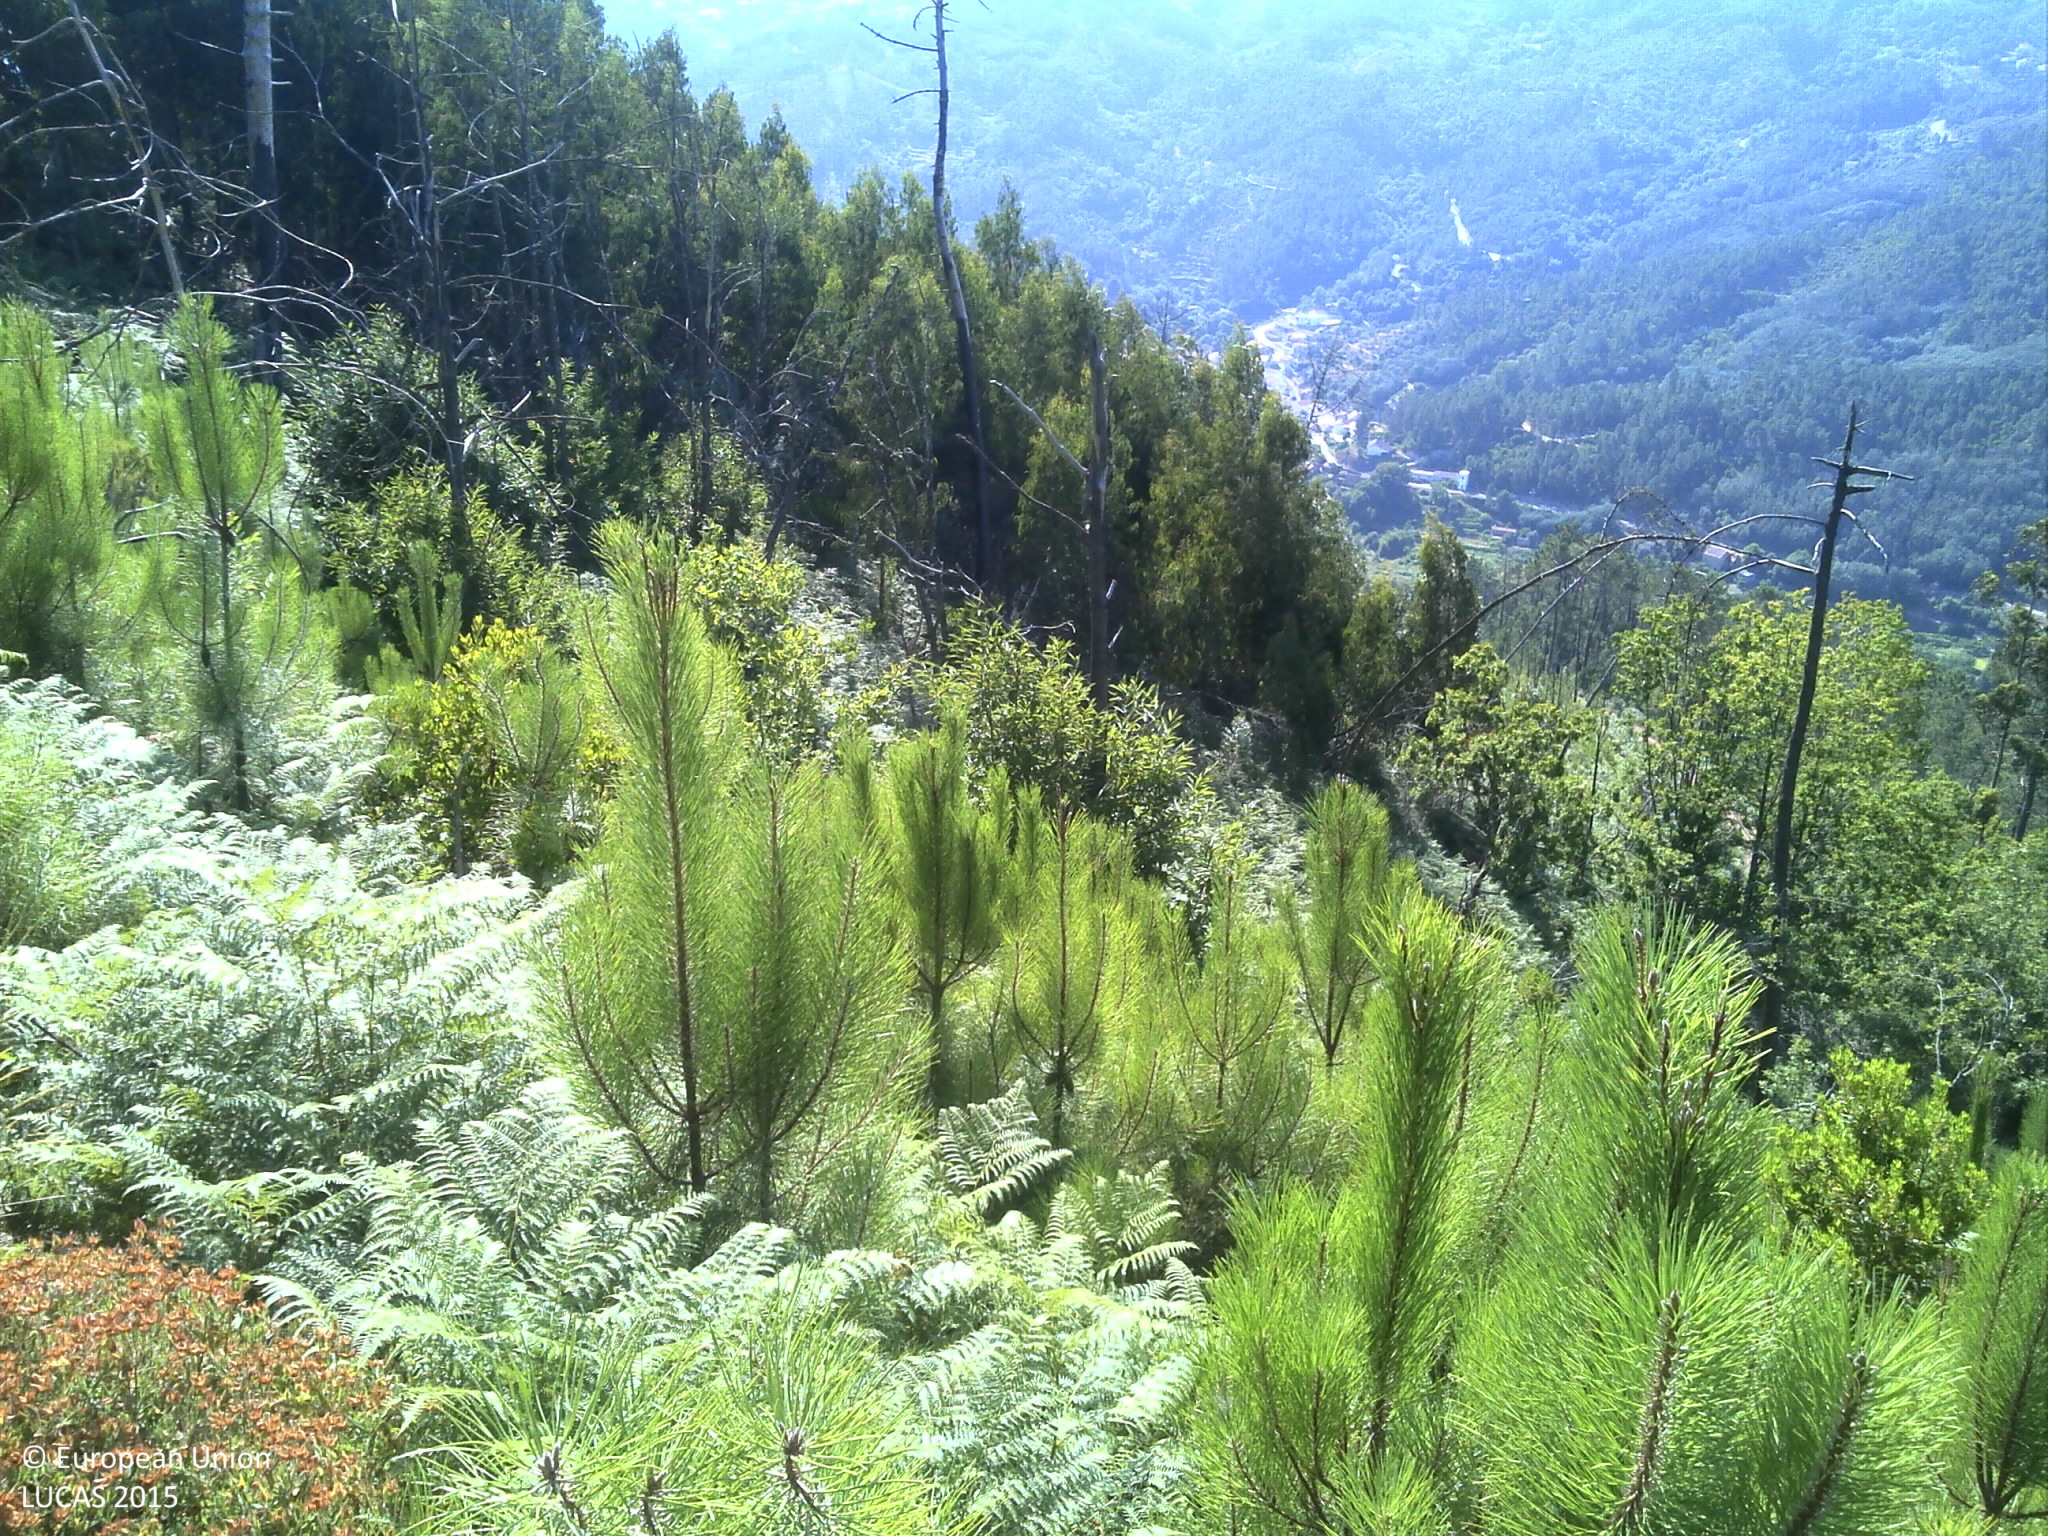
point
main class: Woodland
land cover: Pine dominated coniferous woodland
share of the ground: 50 - 75 %
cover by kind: coniferous forest trees 70 %, shrubs 30 %
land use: Forestry
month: July
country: PT
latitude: 40.3147
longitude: -7.8503
